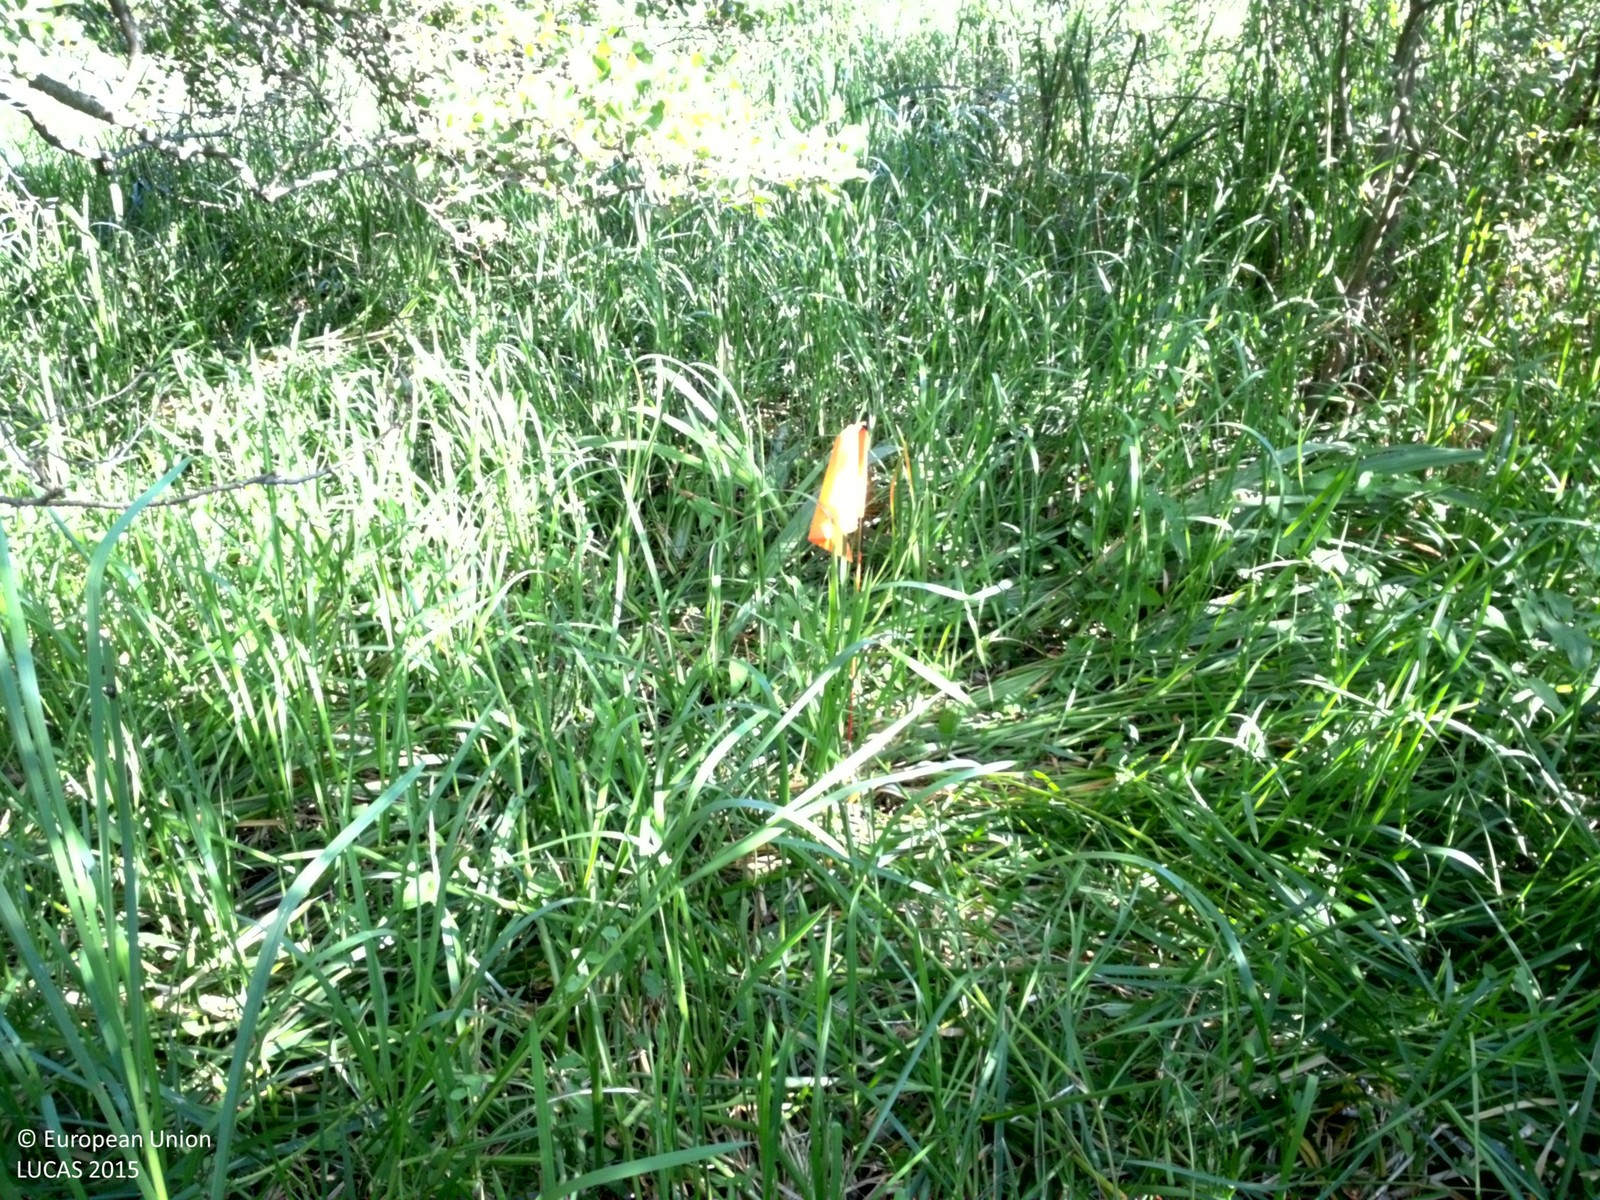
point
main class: Woodland
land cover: Broadleaved woodland
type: boreal forest
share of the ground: 50 - 75 %
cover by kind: broadleaved forest trees 55 %, herbaceous plants 45 %
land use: Forestry
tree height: > 5 m
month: August
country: SE
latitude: 59.6374
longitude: 17.4974
